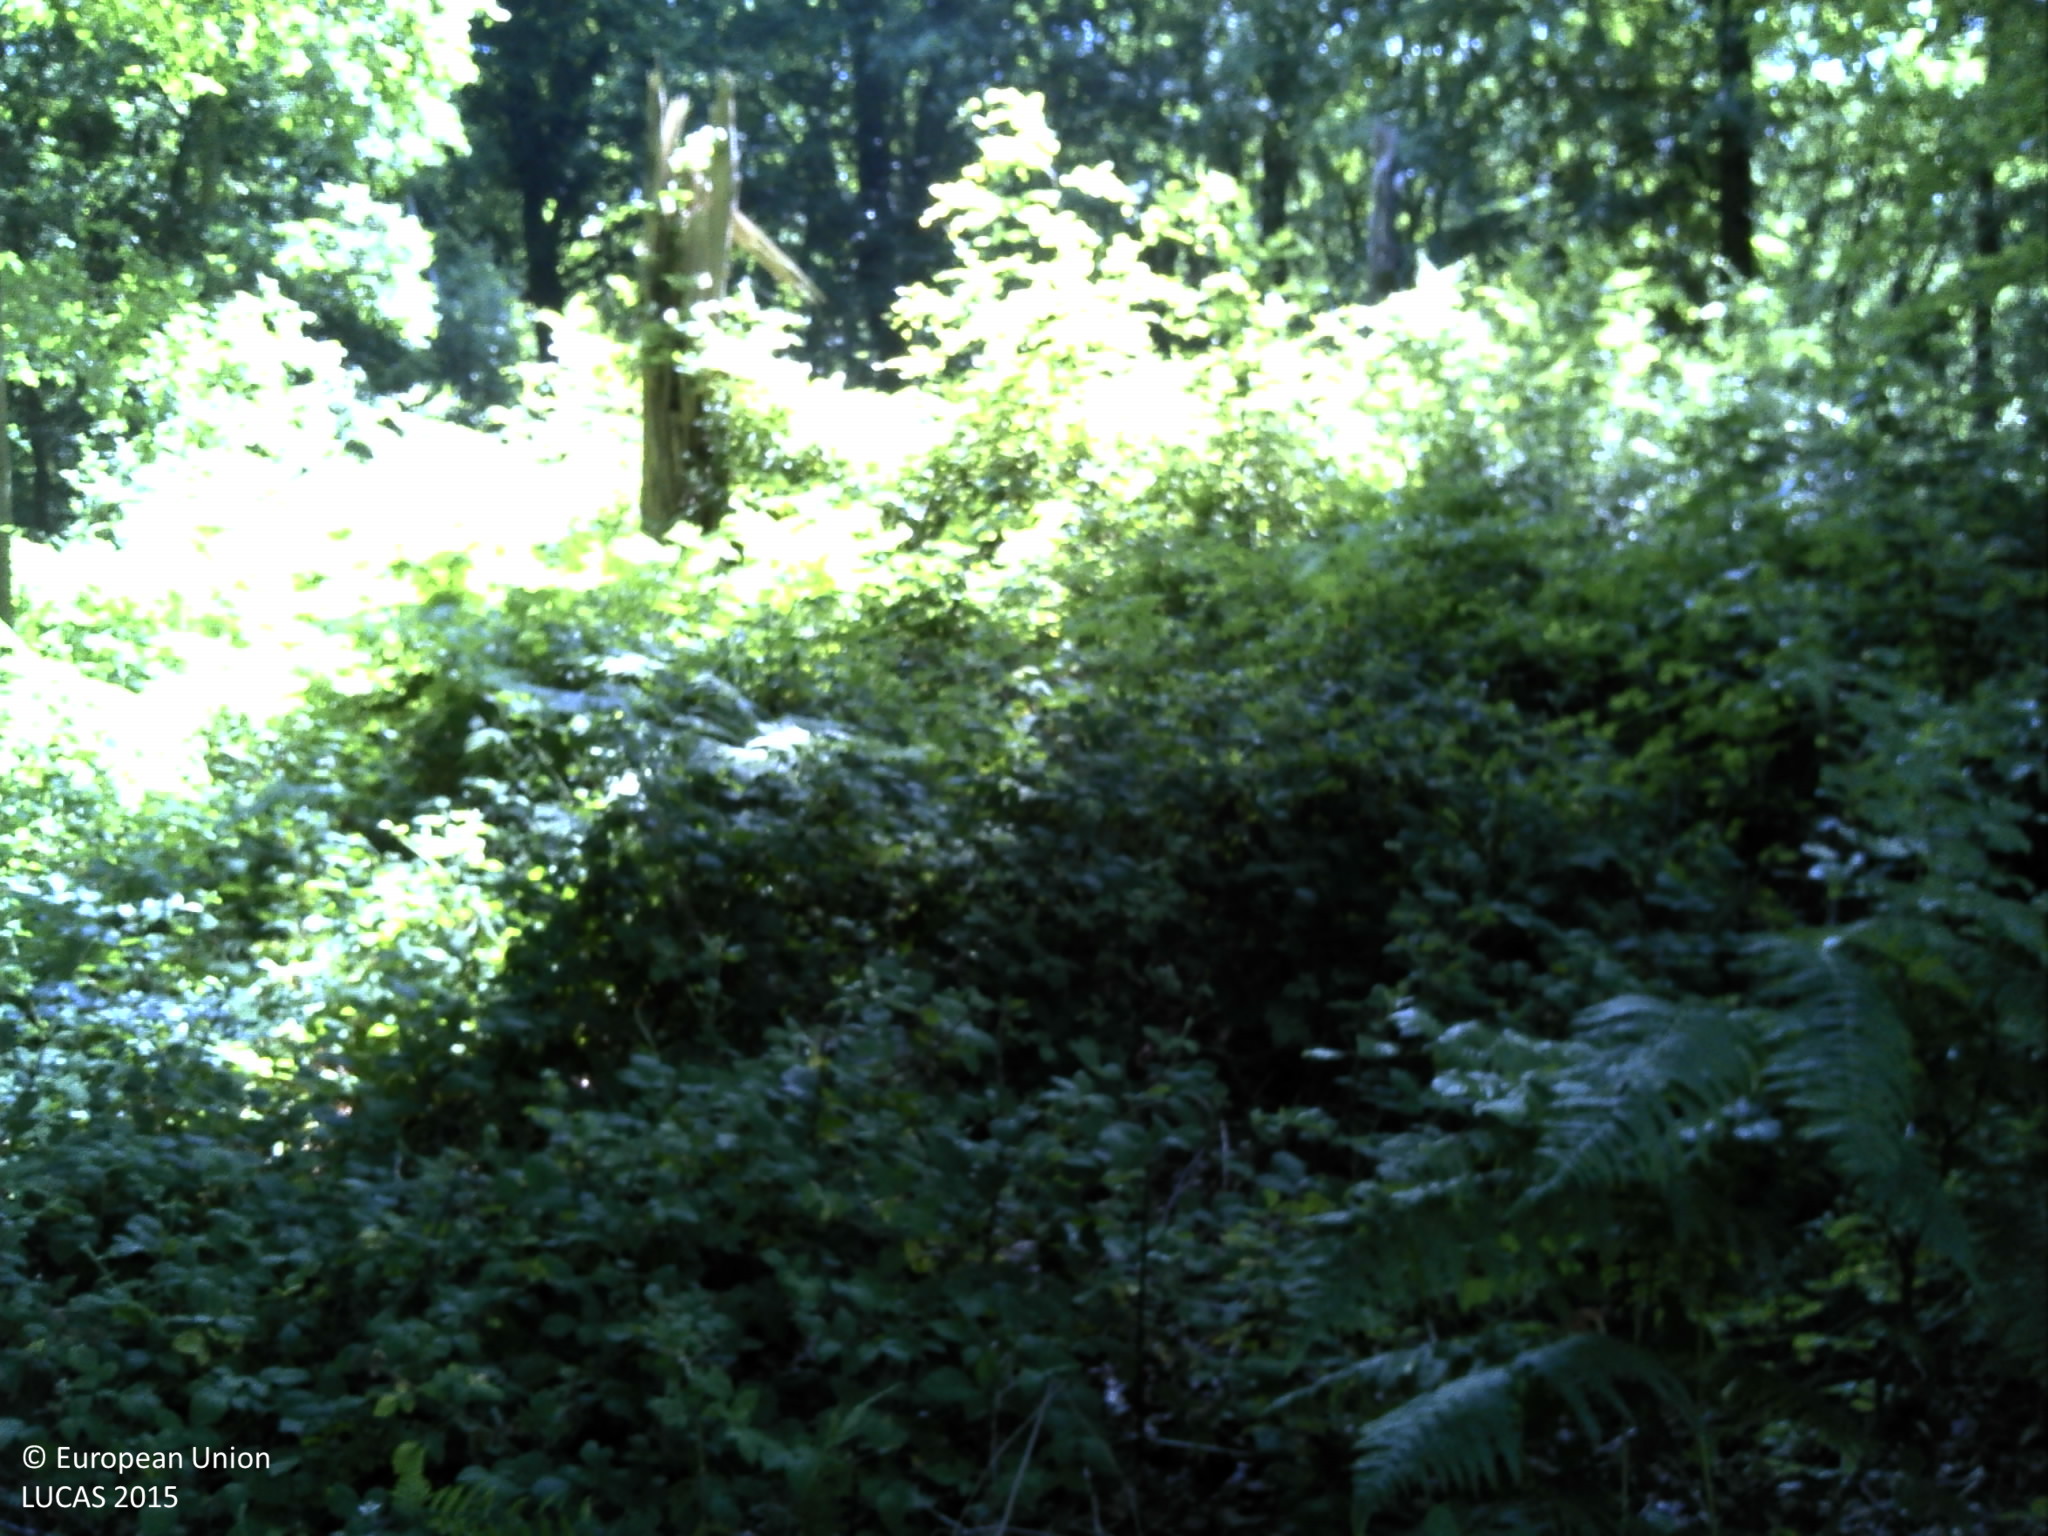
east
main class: Woodland
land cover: Broadleaved woodland
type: acidophilous oak and oak-birch forest
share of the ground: > 75 %
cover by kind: broadleaved forest trees 100 %
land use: Forestry
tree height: > 5 m
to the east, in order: Broadleaved woodland
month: June
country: FR
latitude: 49.4297
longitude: 1.0017
